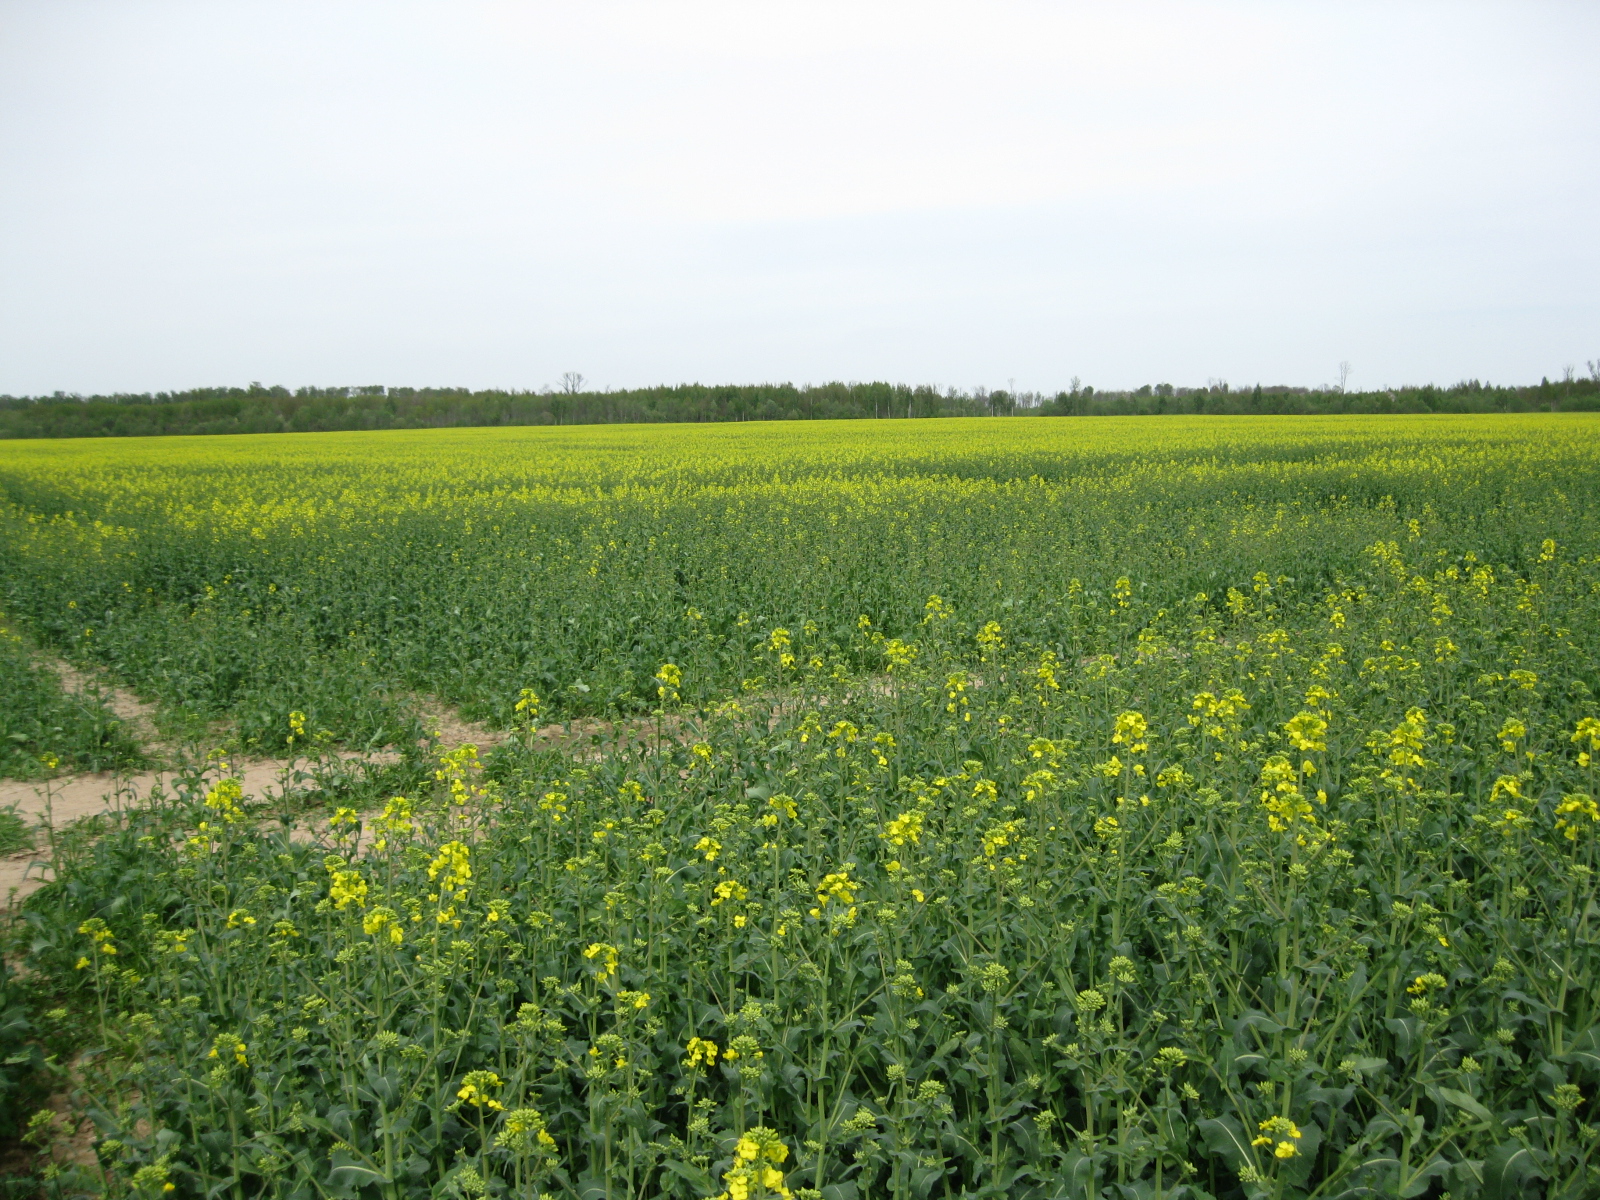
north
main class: Cropland
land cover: Rape and turnip rape
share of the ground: > 75 %
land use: Agriculture (excluding fallow land and kitchen gardens)
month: May
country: LT
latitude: 56.2647
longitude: 24.2510
